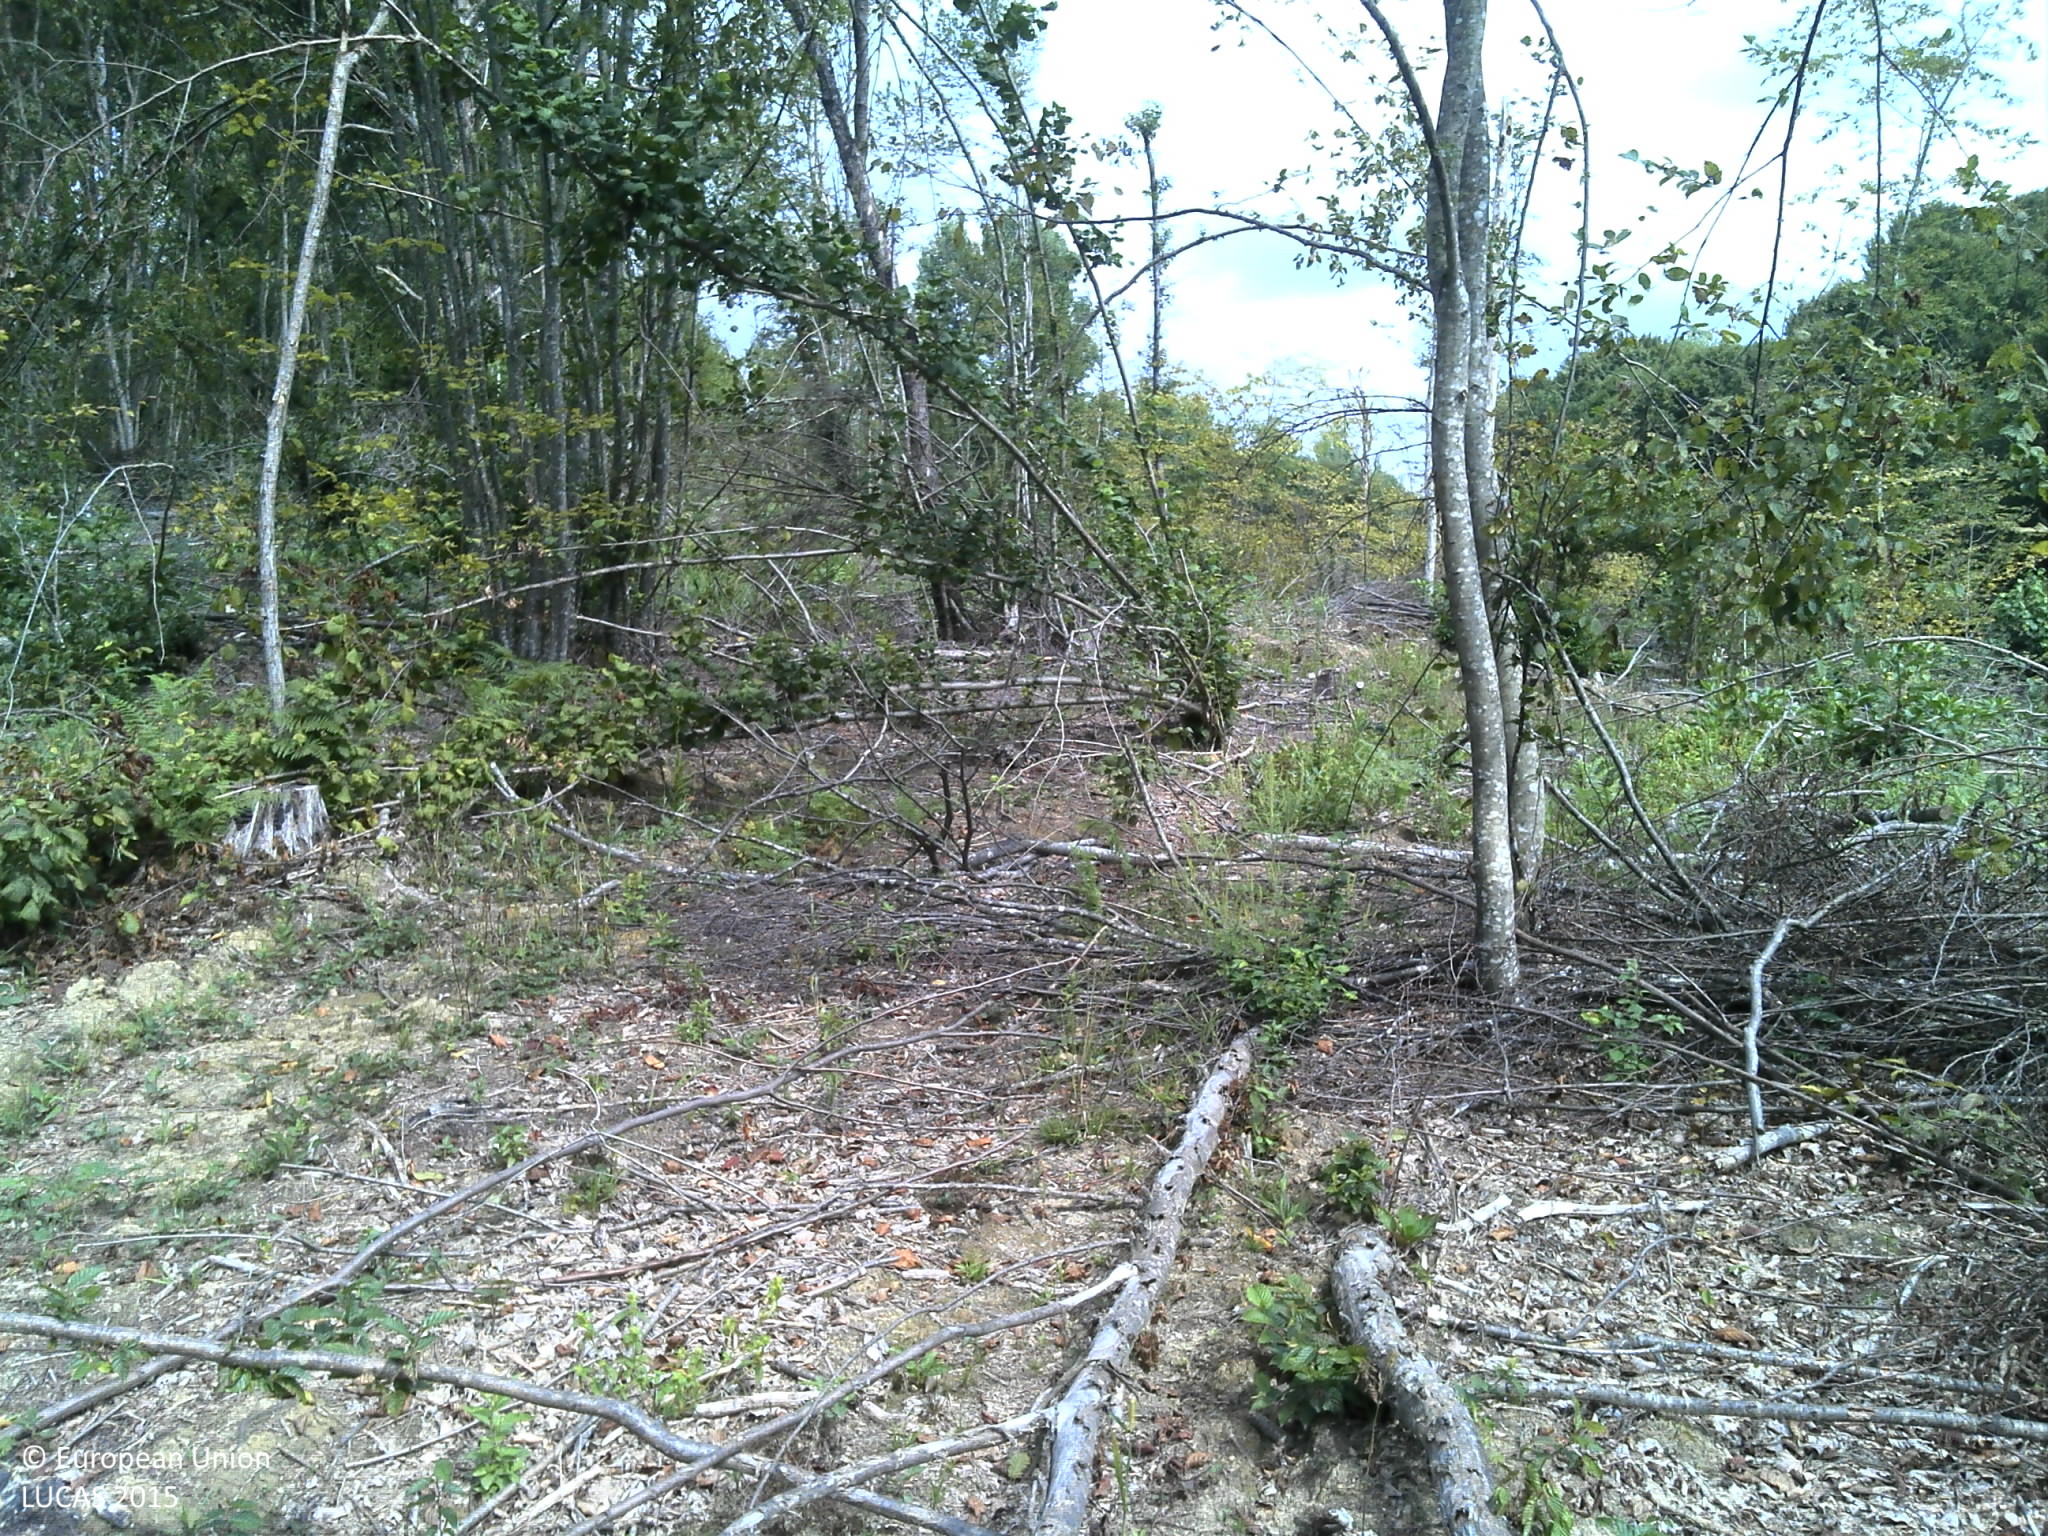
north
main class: Woodland
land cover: Broadleaved woodland
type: beech forest
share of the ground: > 75 %
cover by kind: broadleaved forest trees 100 %
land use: Forestry
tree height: > 5 m
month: August
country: HR
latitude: 45.3363
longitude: 15.9557
